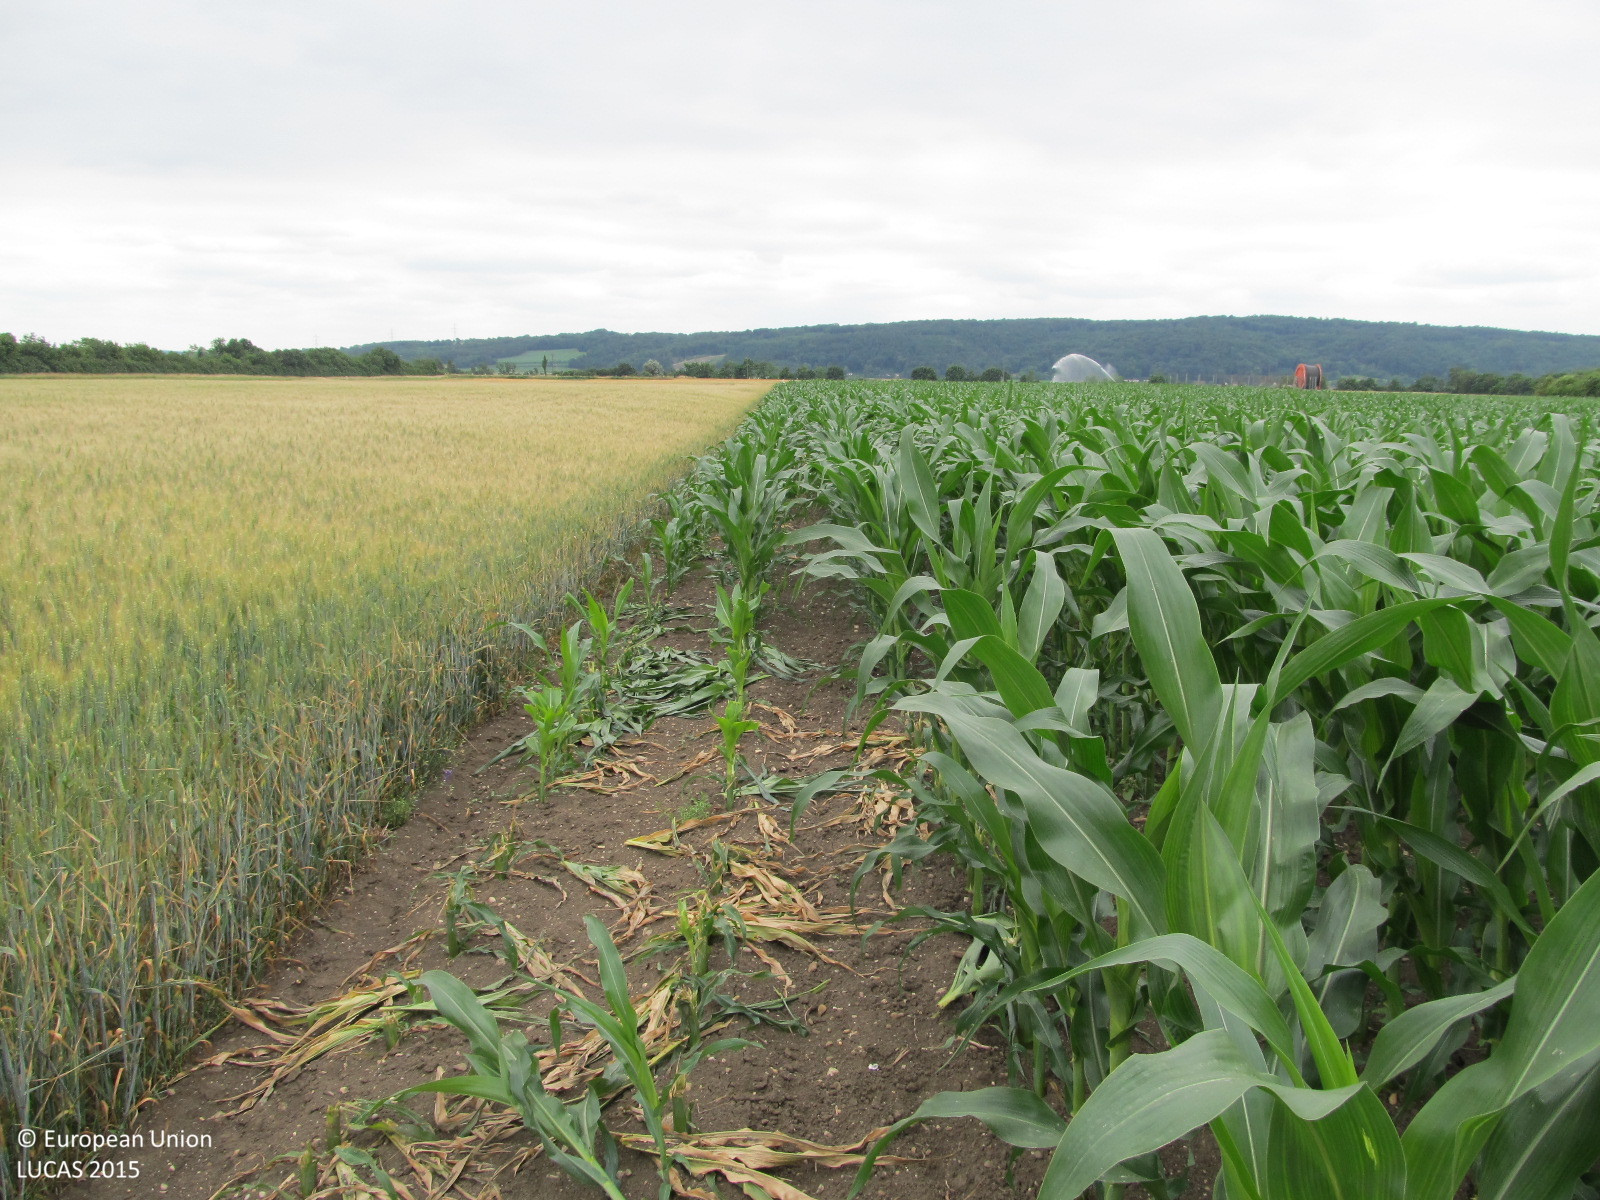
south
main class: Cropland
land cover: Maize
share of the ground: 50 - 75 %
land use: Agriculture (excluding fallow land and kitchen gardens)
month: June
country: AT
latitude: 48.3391
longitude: 15.8451
